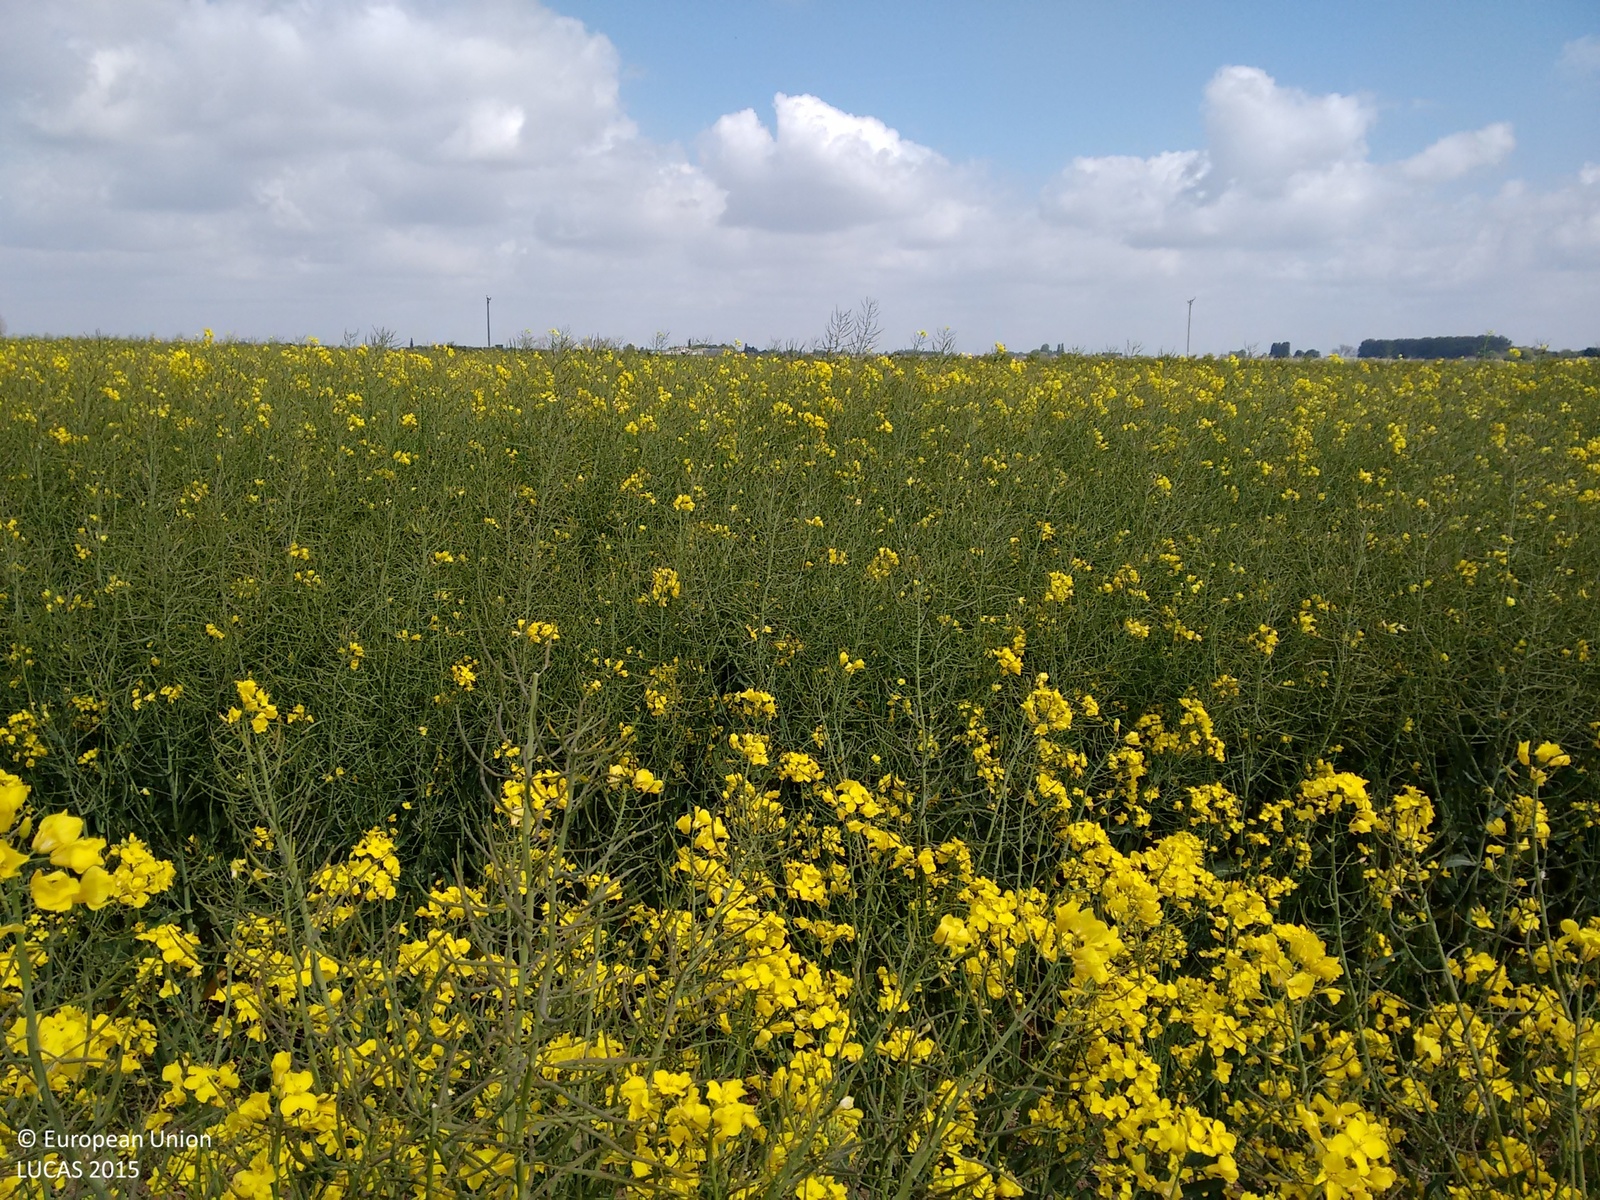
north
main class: Cropland
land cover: Rape and turnip rape
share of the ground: > 75 %
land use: Agriculture (excluding fallow land and kitchen gardens)
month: May
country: GB
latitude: 52.7260
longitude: -0.0872
